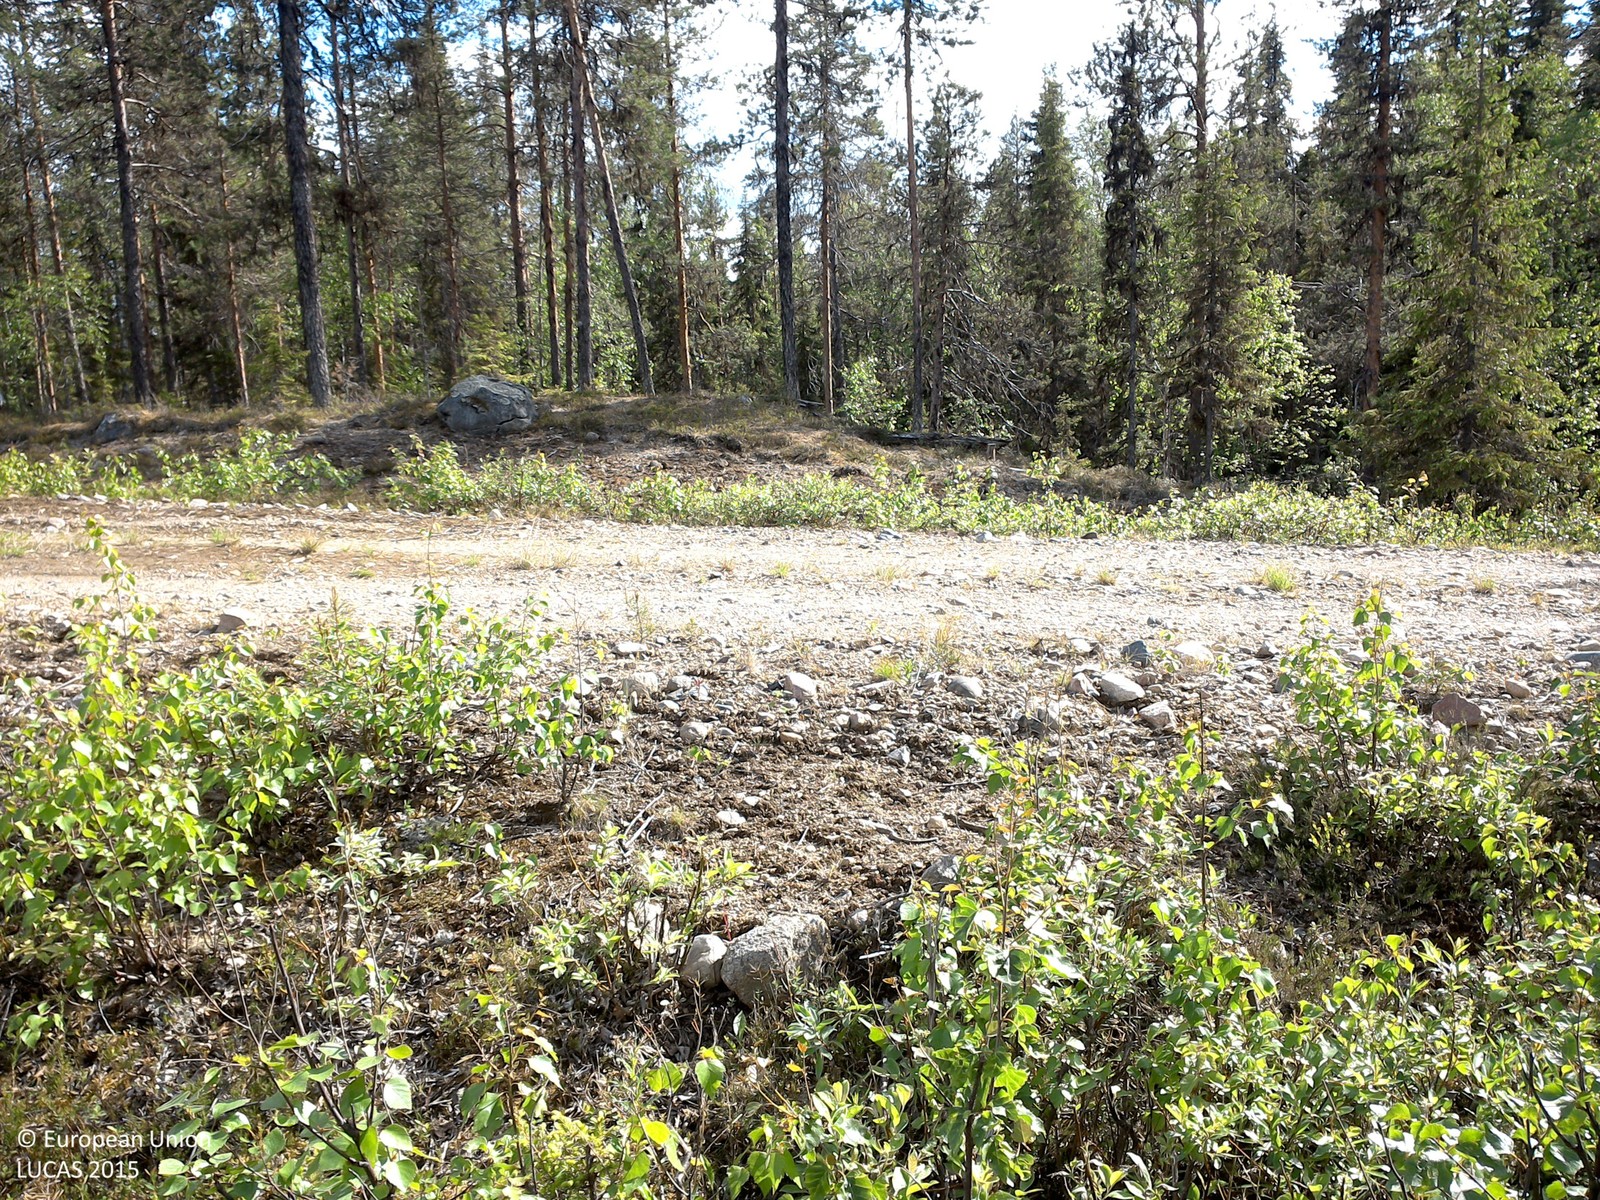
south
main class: Woodland
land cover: Pine dominated mixed woodland
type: boreal forest
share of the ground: 25 - 50 %
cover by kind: shrubs 65 %, coniferous forest trees 15 %, broadleaved forest trees 10 %, lichens and mosses 5 %, unconsolidated bare surface 5 %
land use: Forestry
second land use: Amenities, museums, leisure
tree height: > 5 m
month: June
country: SE
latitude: 66.6308
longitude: 22.8287
